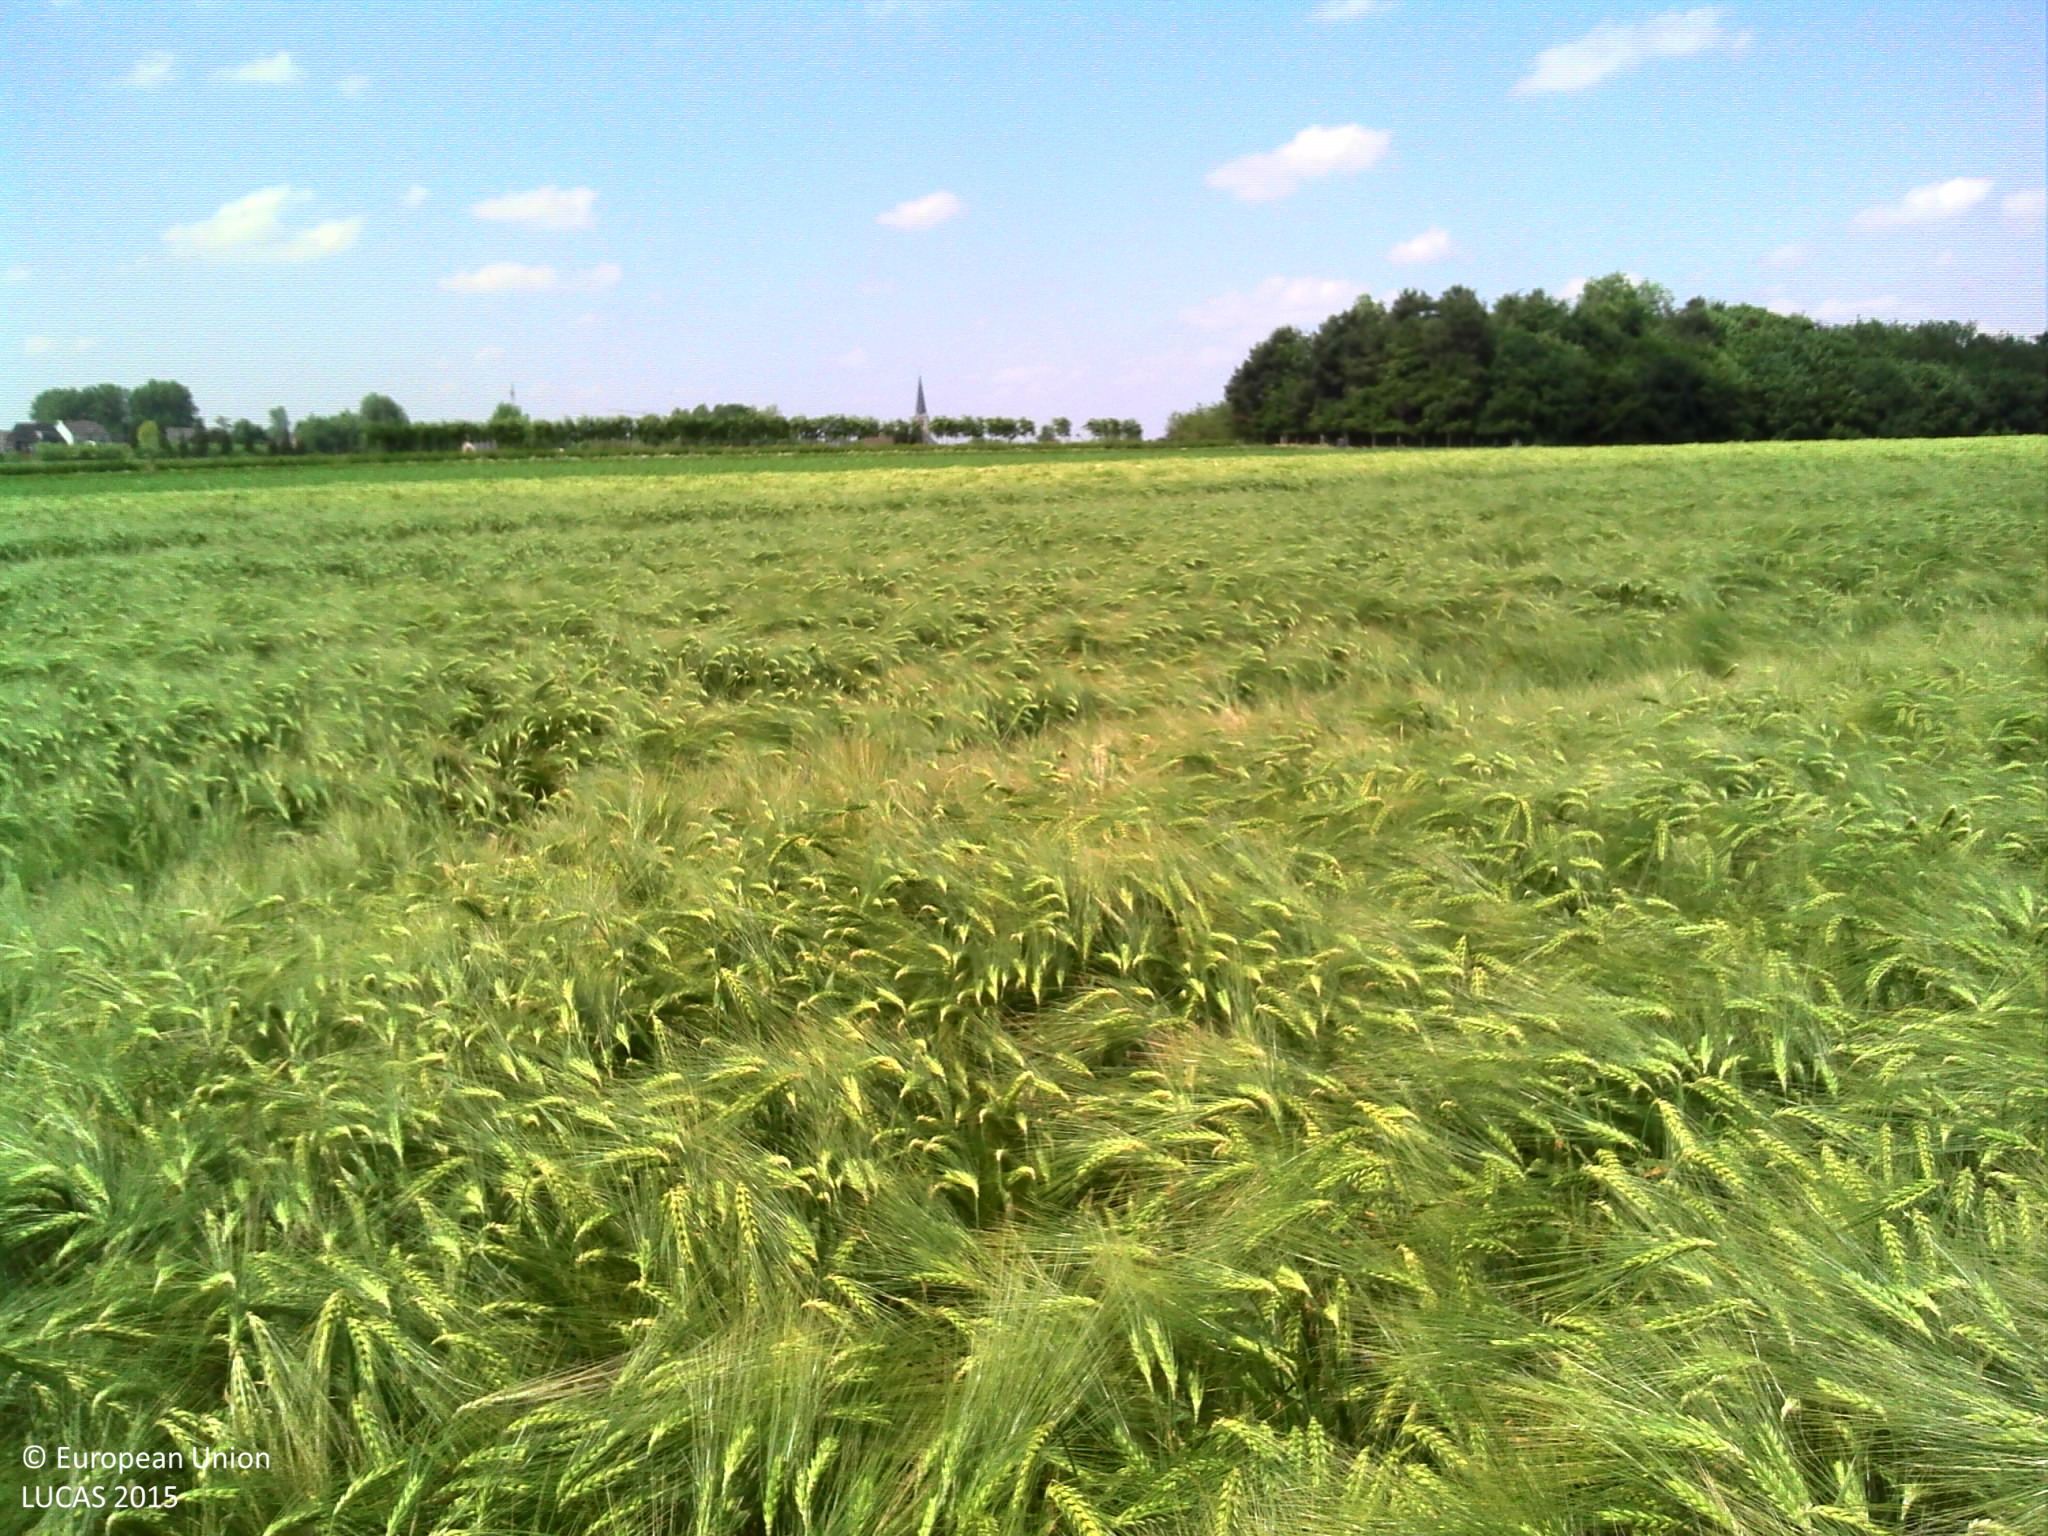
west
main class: Cropland
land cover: Barley
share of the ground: > 75 %
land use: Agriculture (excluding fallow land and kitchen gardens)
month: June
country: BE
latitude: 50.9594
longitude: 3.9145
